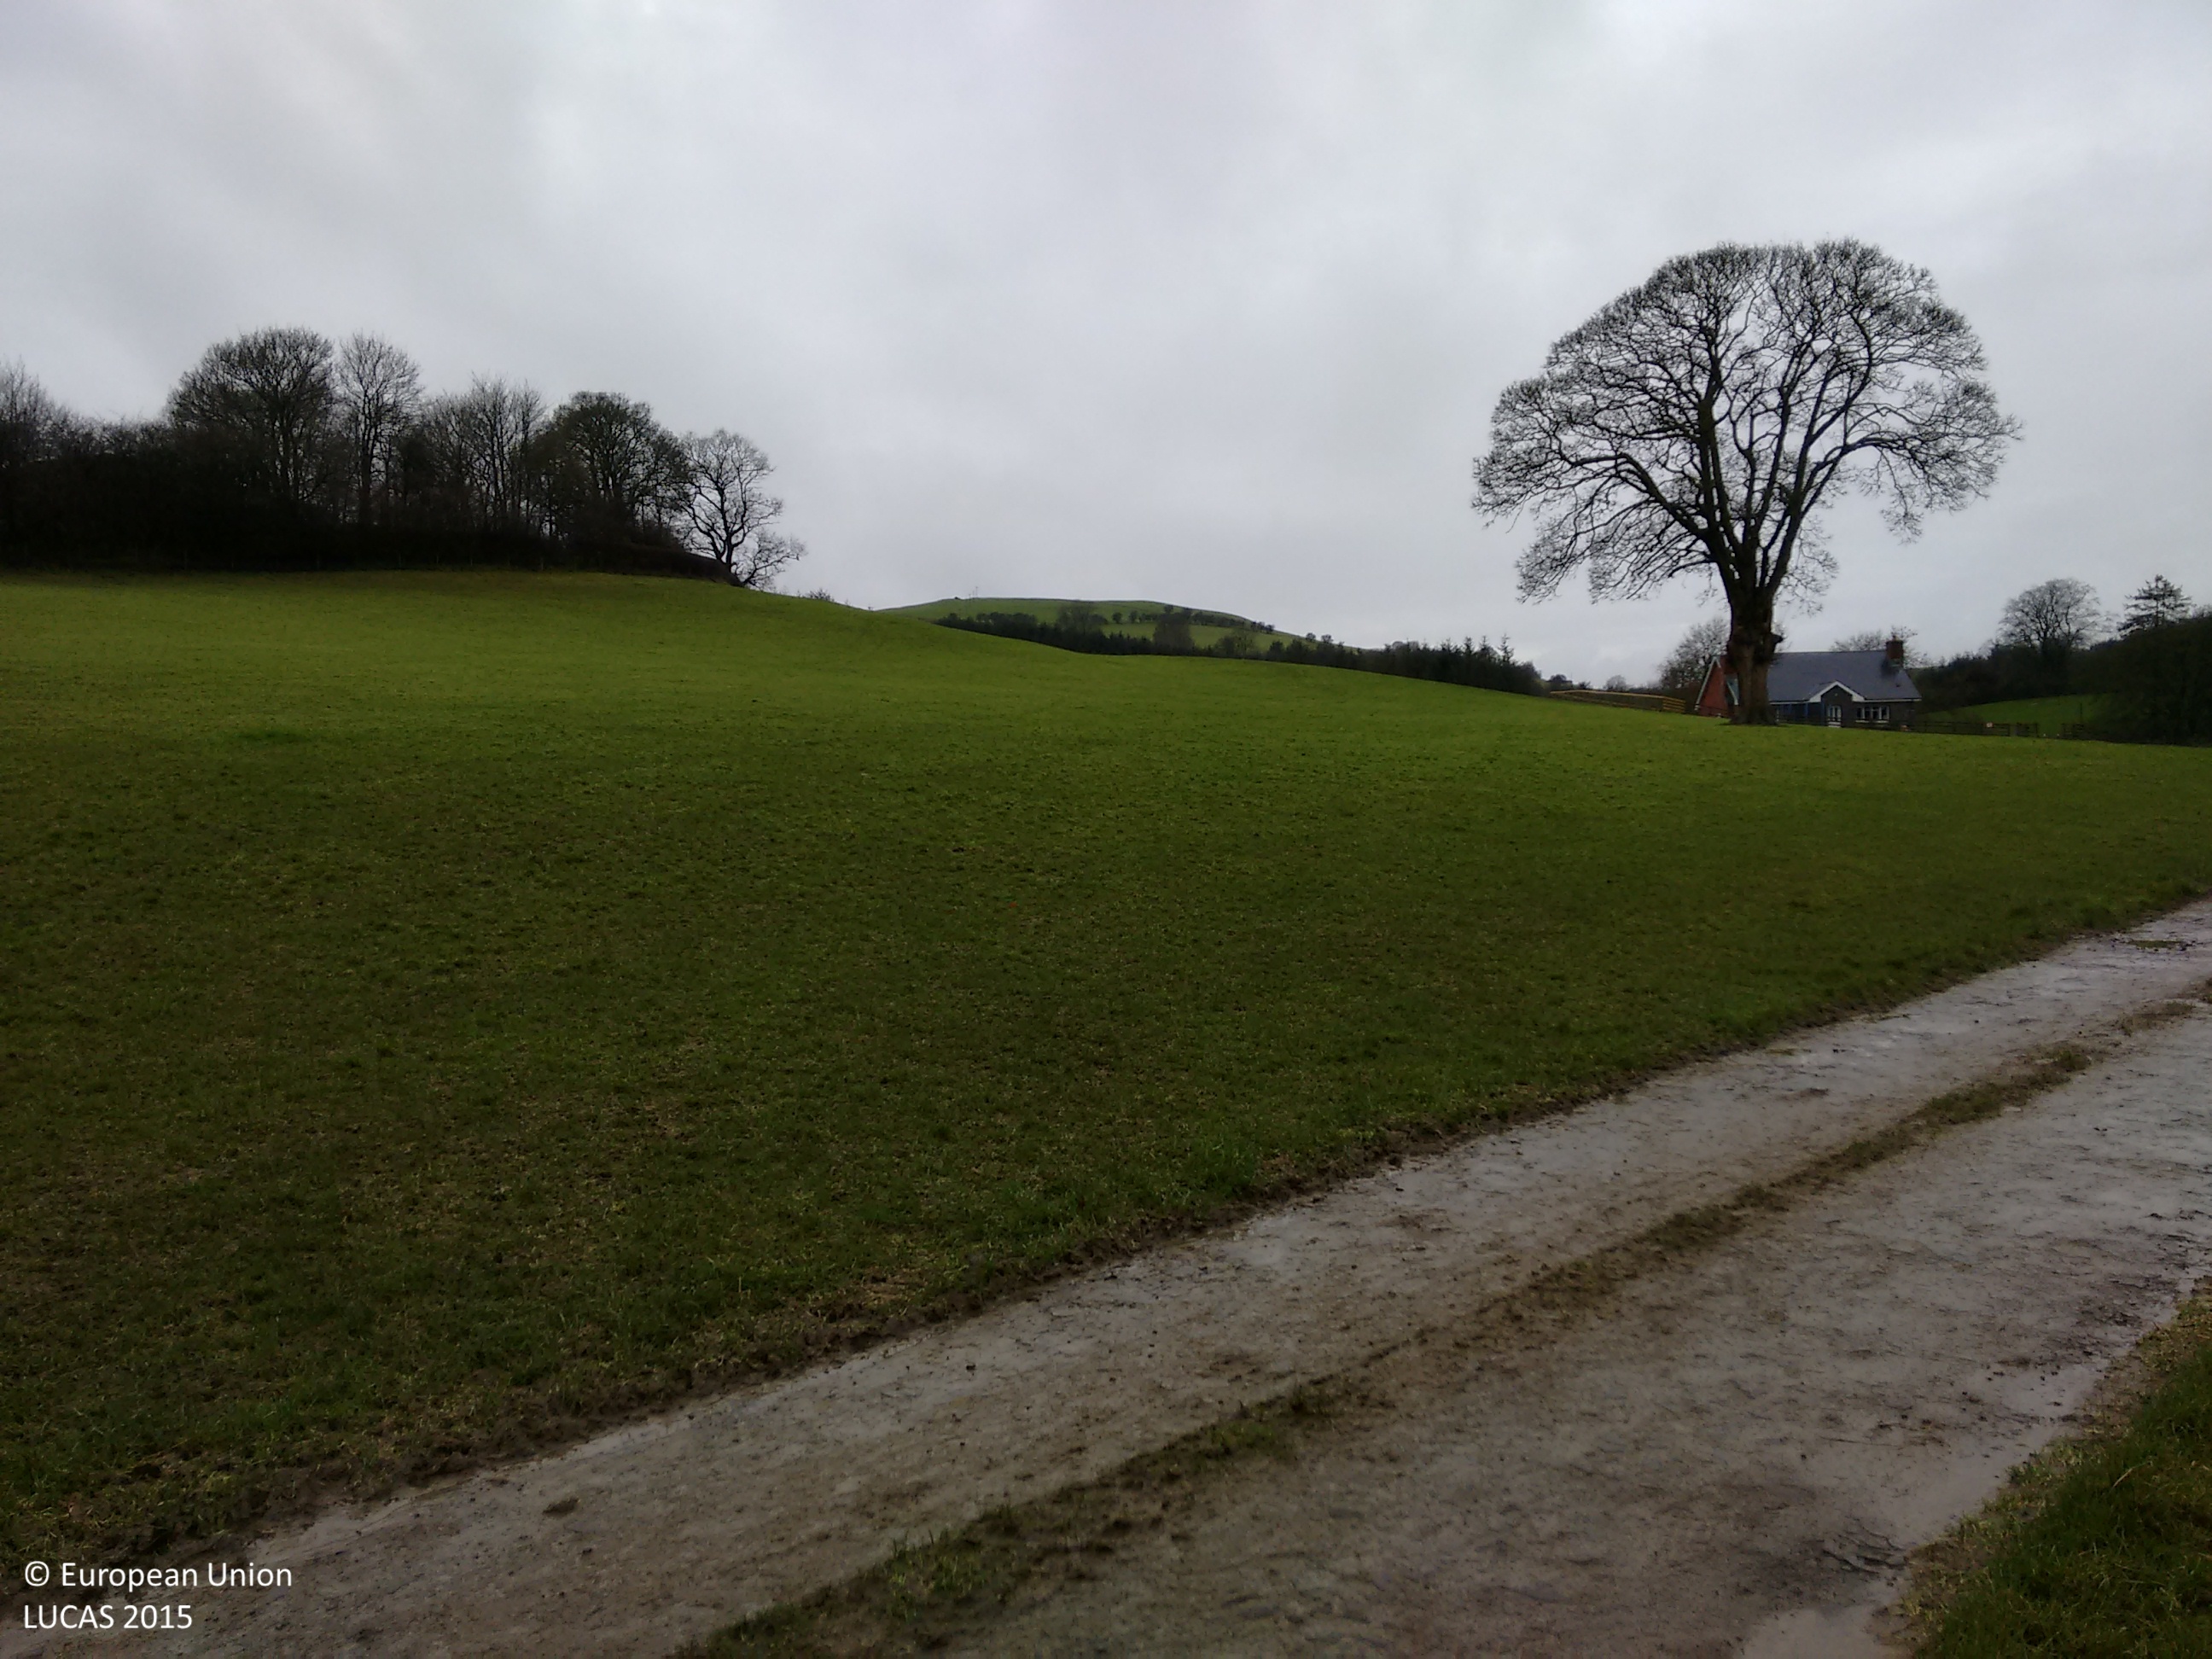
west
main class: Grassland
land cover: Grassland without tree/shrub cover
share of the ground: > 75 %
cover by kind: herbaceous plants 100 %
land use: Agriculture (excluding fallow land and kitchen gardens)
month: December
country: GB
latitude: 52.2185
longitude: -3.2086
